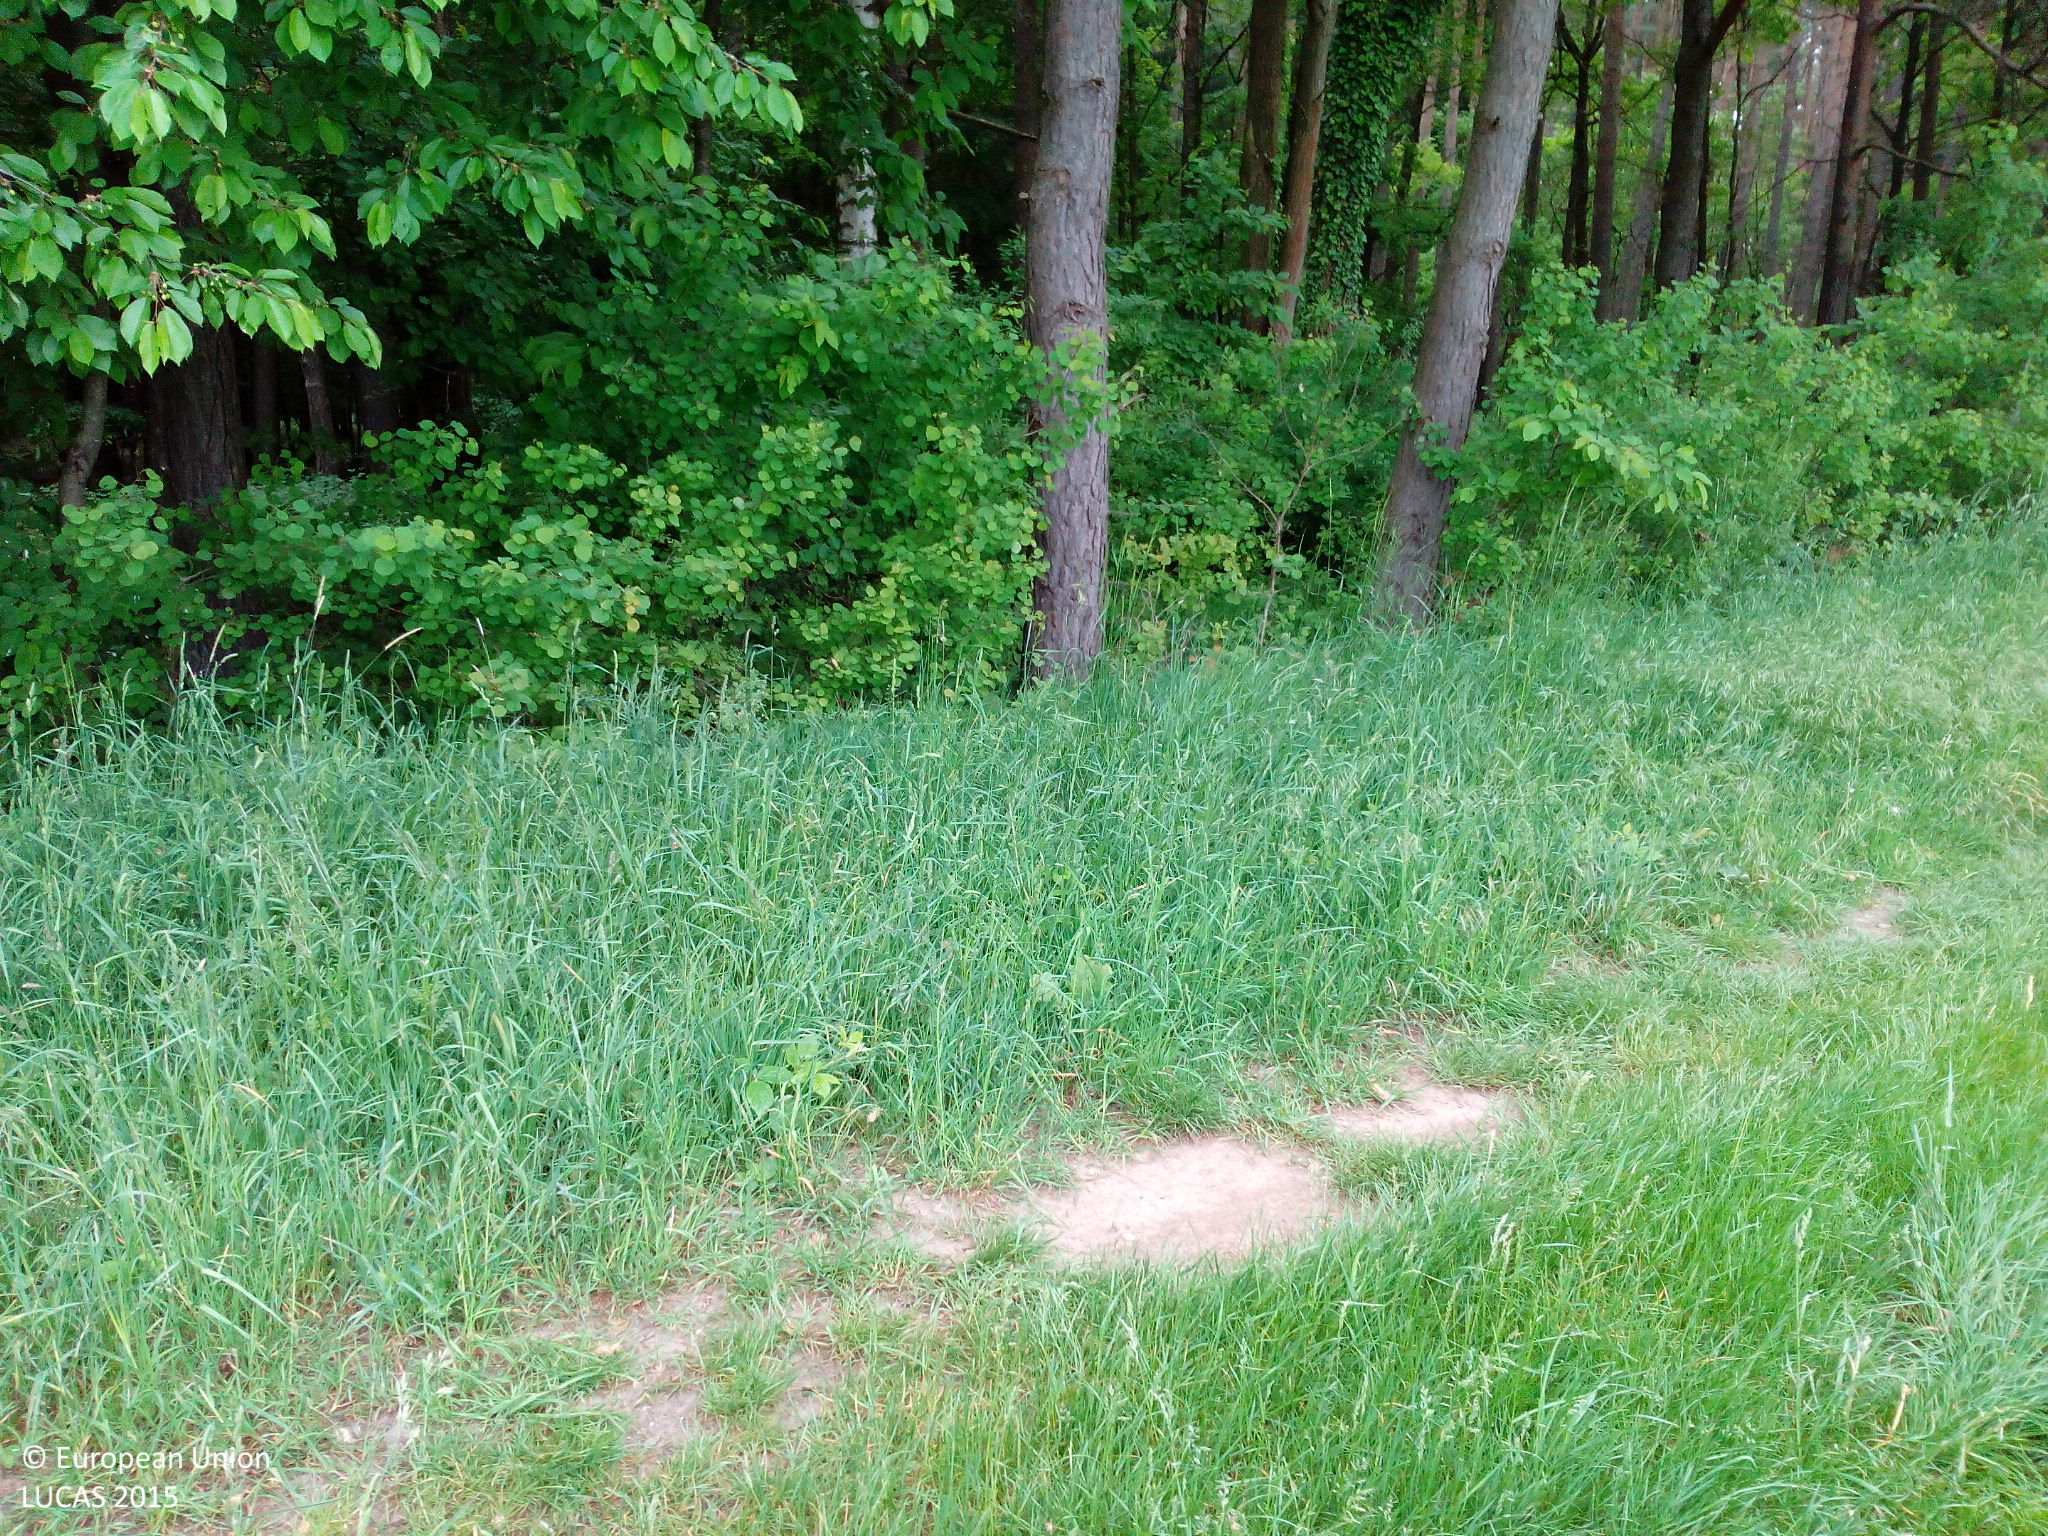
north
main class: Artificial land
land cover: Other artificial areas
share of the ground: > 75 %
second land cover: Rape and turnip rape
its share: > 75 %
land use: Electricity, gas and thermal power distribution
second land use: Agriculture (excluding fallow land and kitchen gardens)
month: May
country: DE
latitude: 49.2473
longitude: 10.6179
